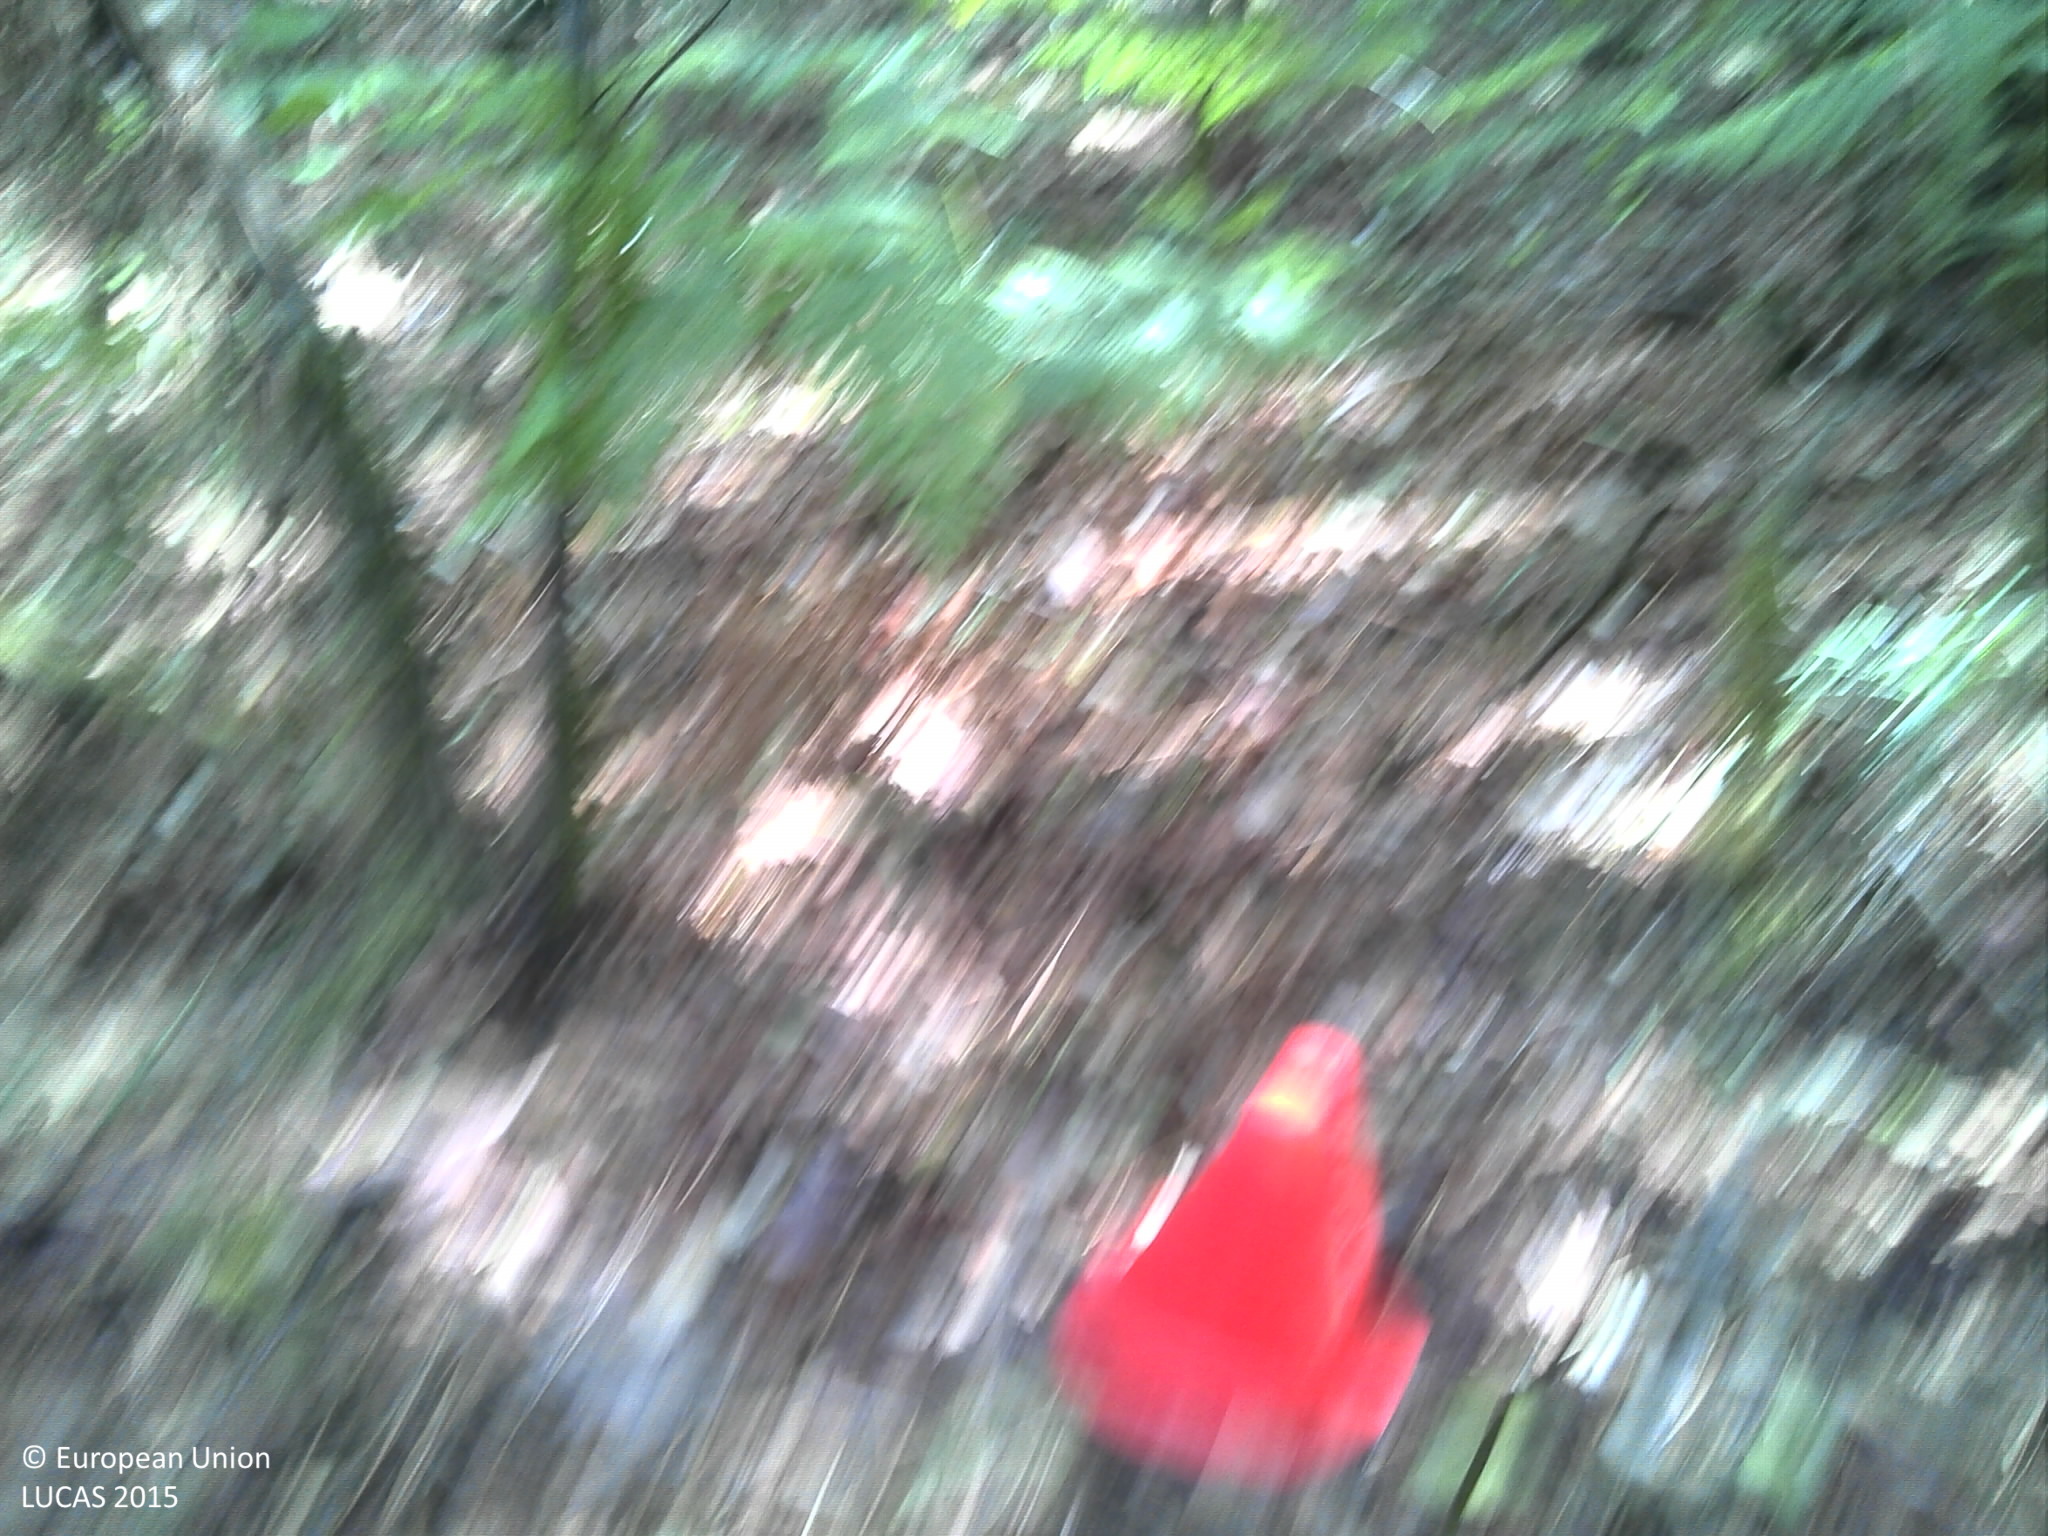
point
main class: Woodland
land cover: Broadleaved woodland
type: thermophilous deciduous forest
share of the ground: > 75 %
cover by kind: broadleaved forest trees 85 %, unconsolidated bare surface 10 %, shrubs 5 %
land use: Forestry
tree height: > 5 m
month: May
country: PT
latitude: 40.9069
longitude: -8.3400
